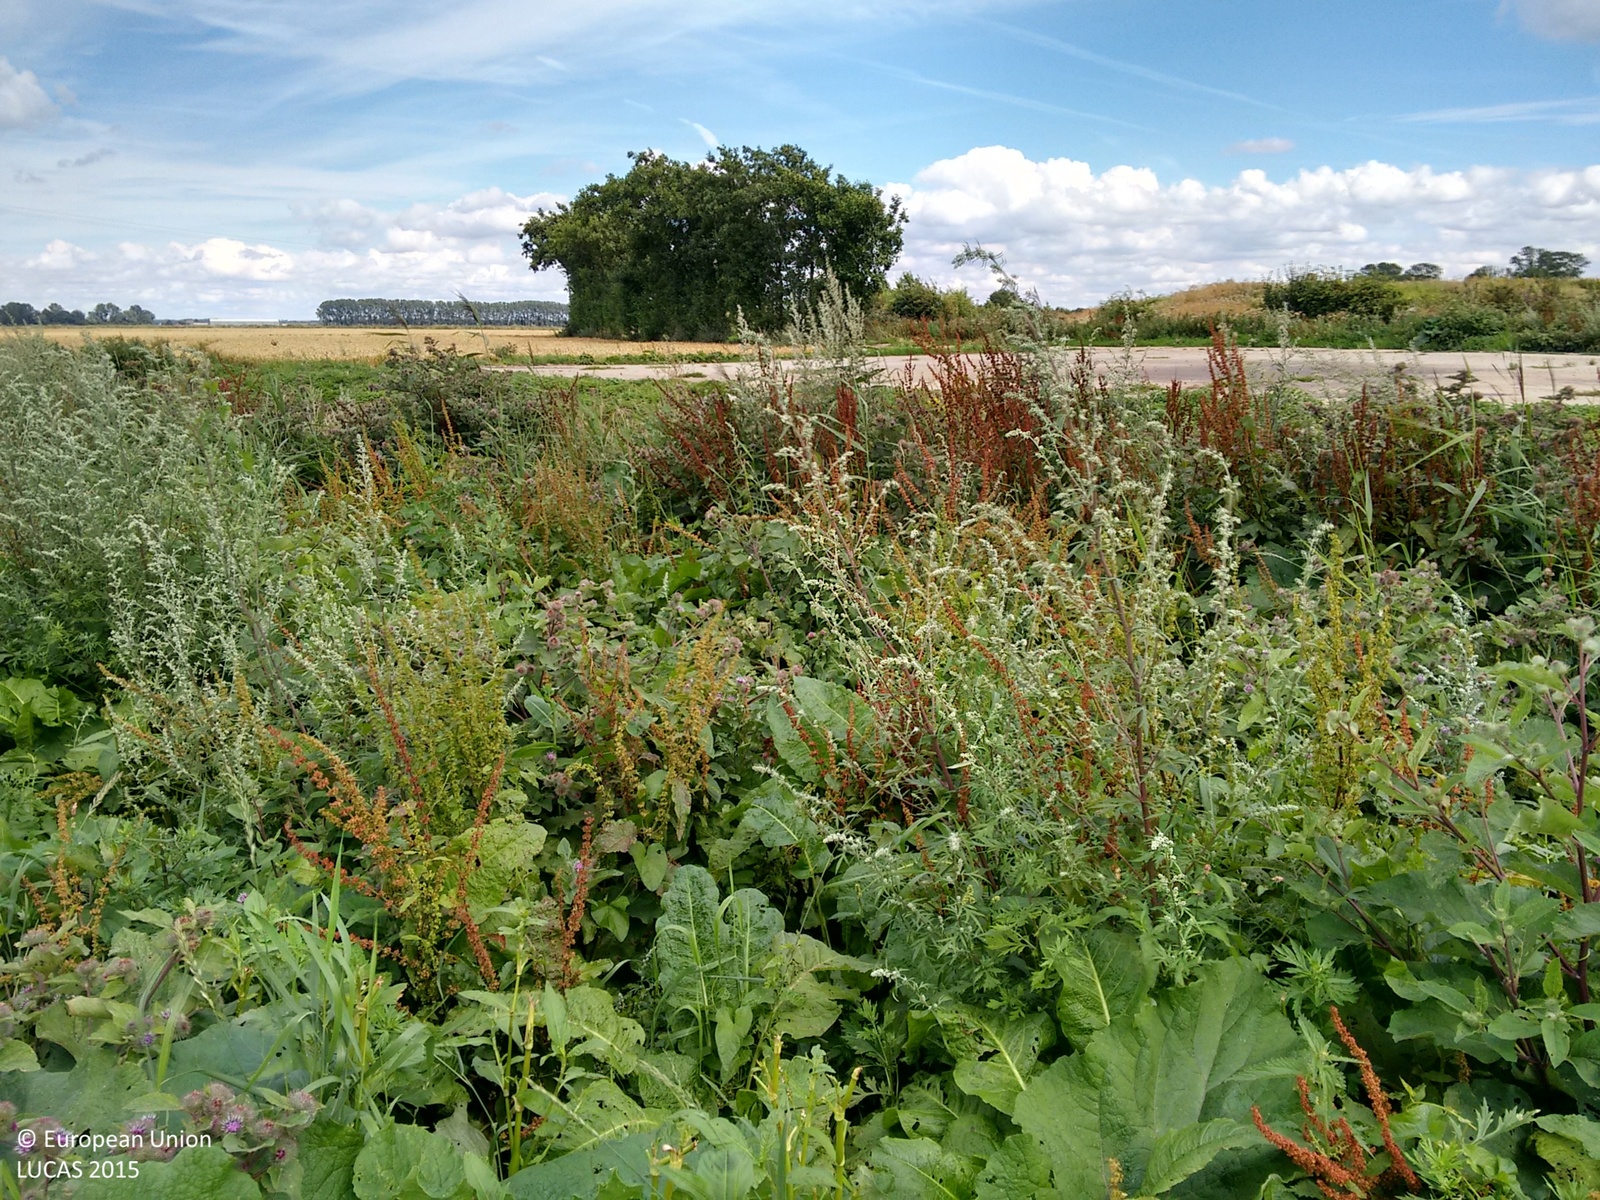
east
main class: Cropland
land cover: Common wheat
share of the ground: > 75 %
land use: Agriculture (excluding fallow land and kitchen gardens)
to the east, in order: Common wheat; Spontaneously vegetated surfaces; Managed hedges; Electric lines; Spontaneously vegetated surfaces; Common wheat
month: August
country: GB
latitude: 52.4802
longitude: 0.4454
